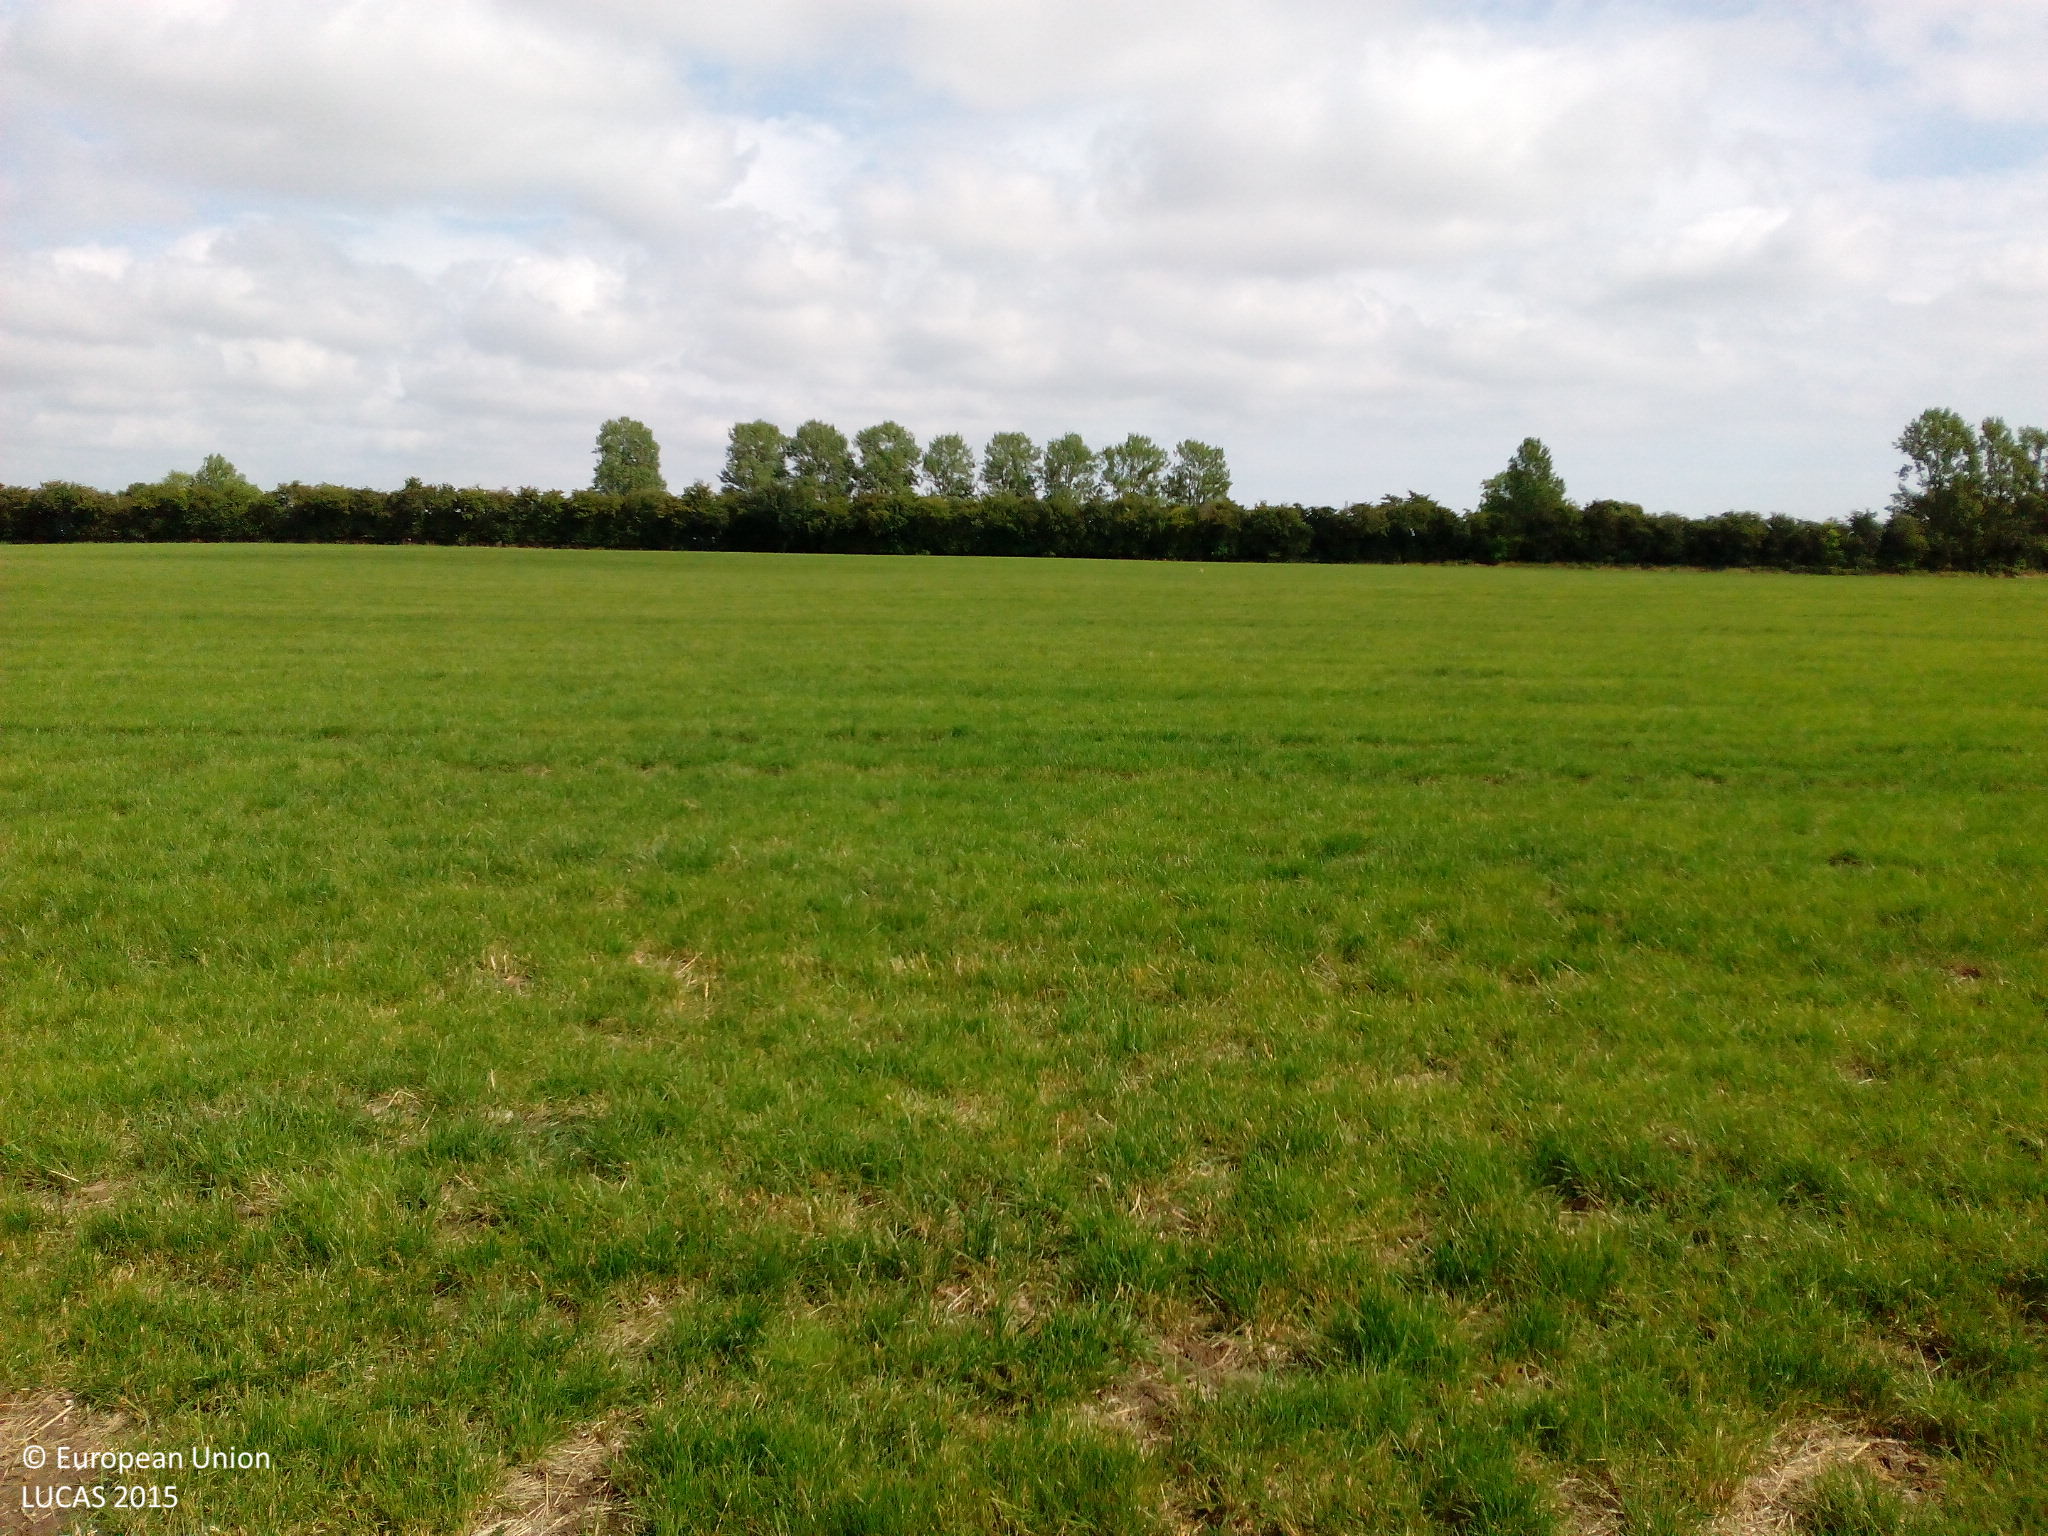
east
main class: Cropland
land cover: Barley
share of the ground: > 75 %
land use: Agriculture (excluding fallow land and kitchen gardens)
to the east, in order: Barley; Temporary grasslands; Broadleaved woodland; Rape and turnip rape
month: August
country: DK
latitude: 55.5760
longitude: 12.1712
